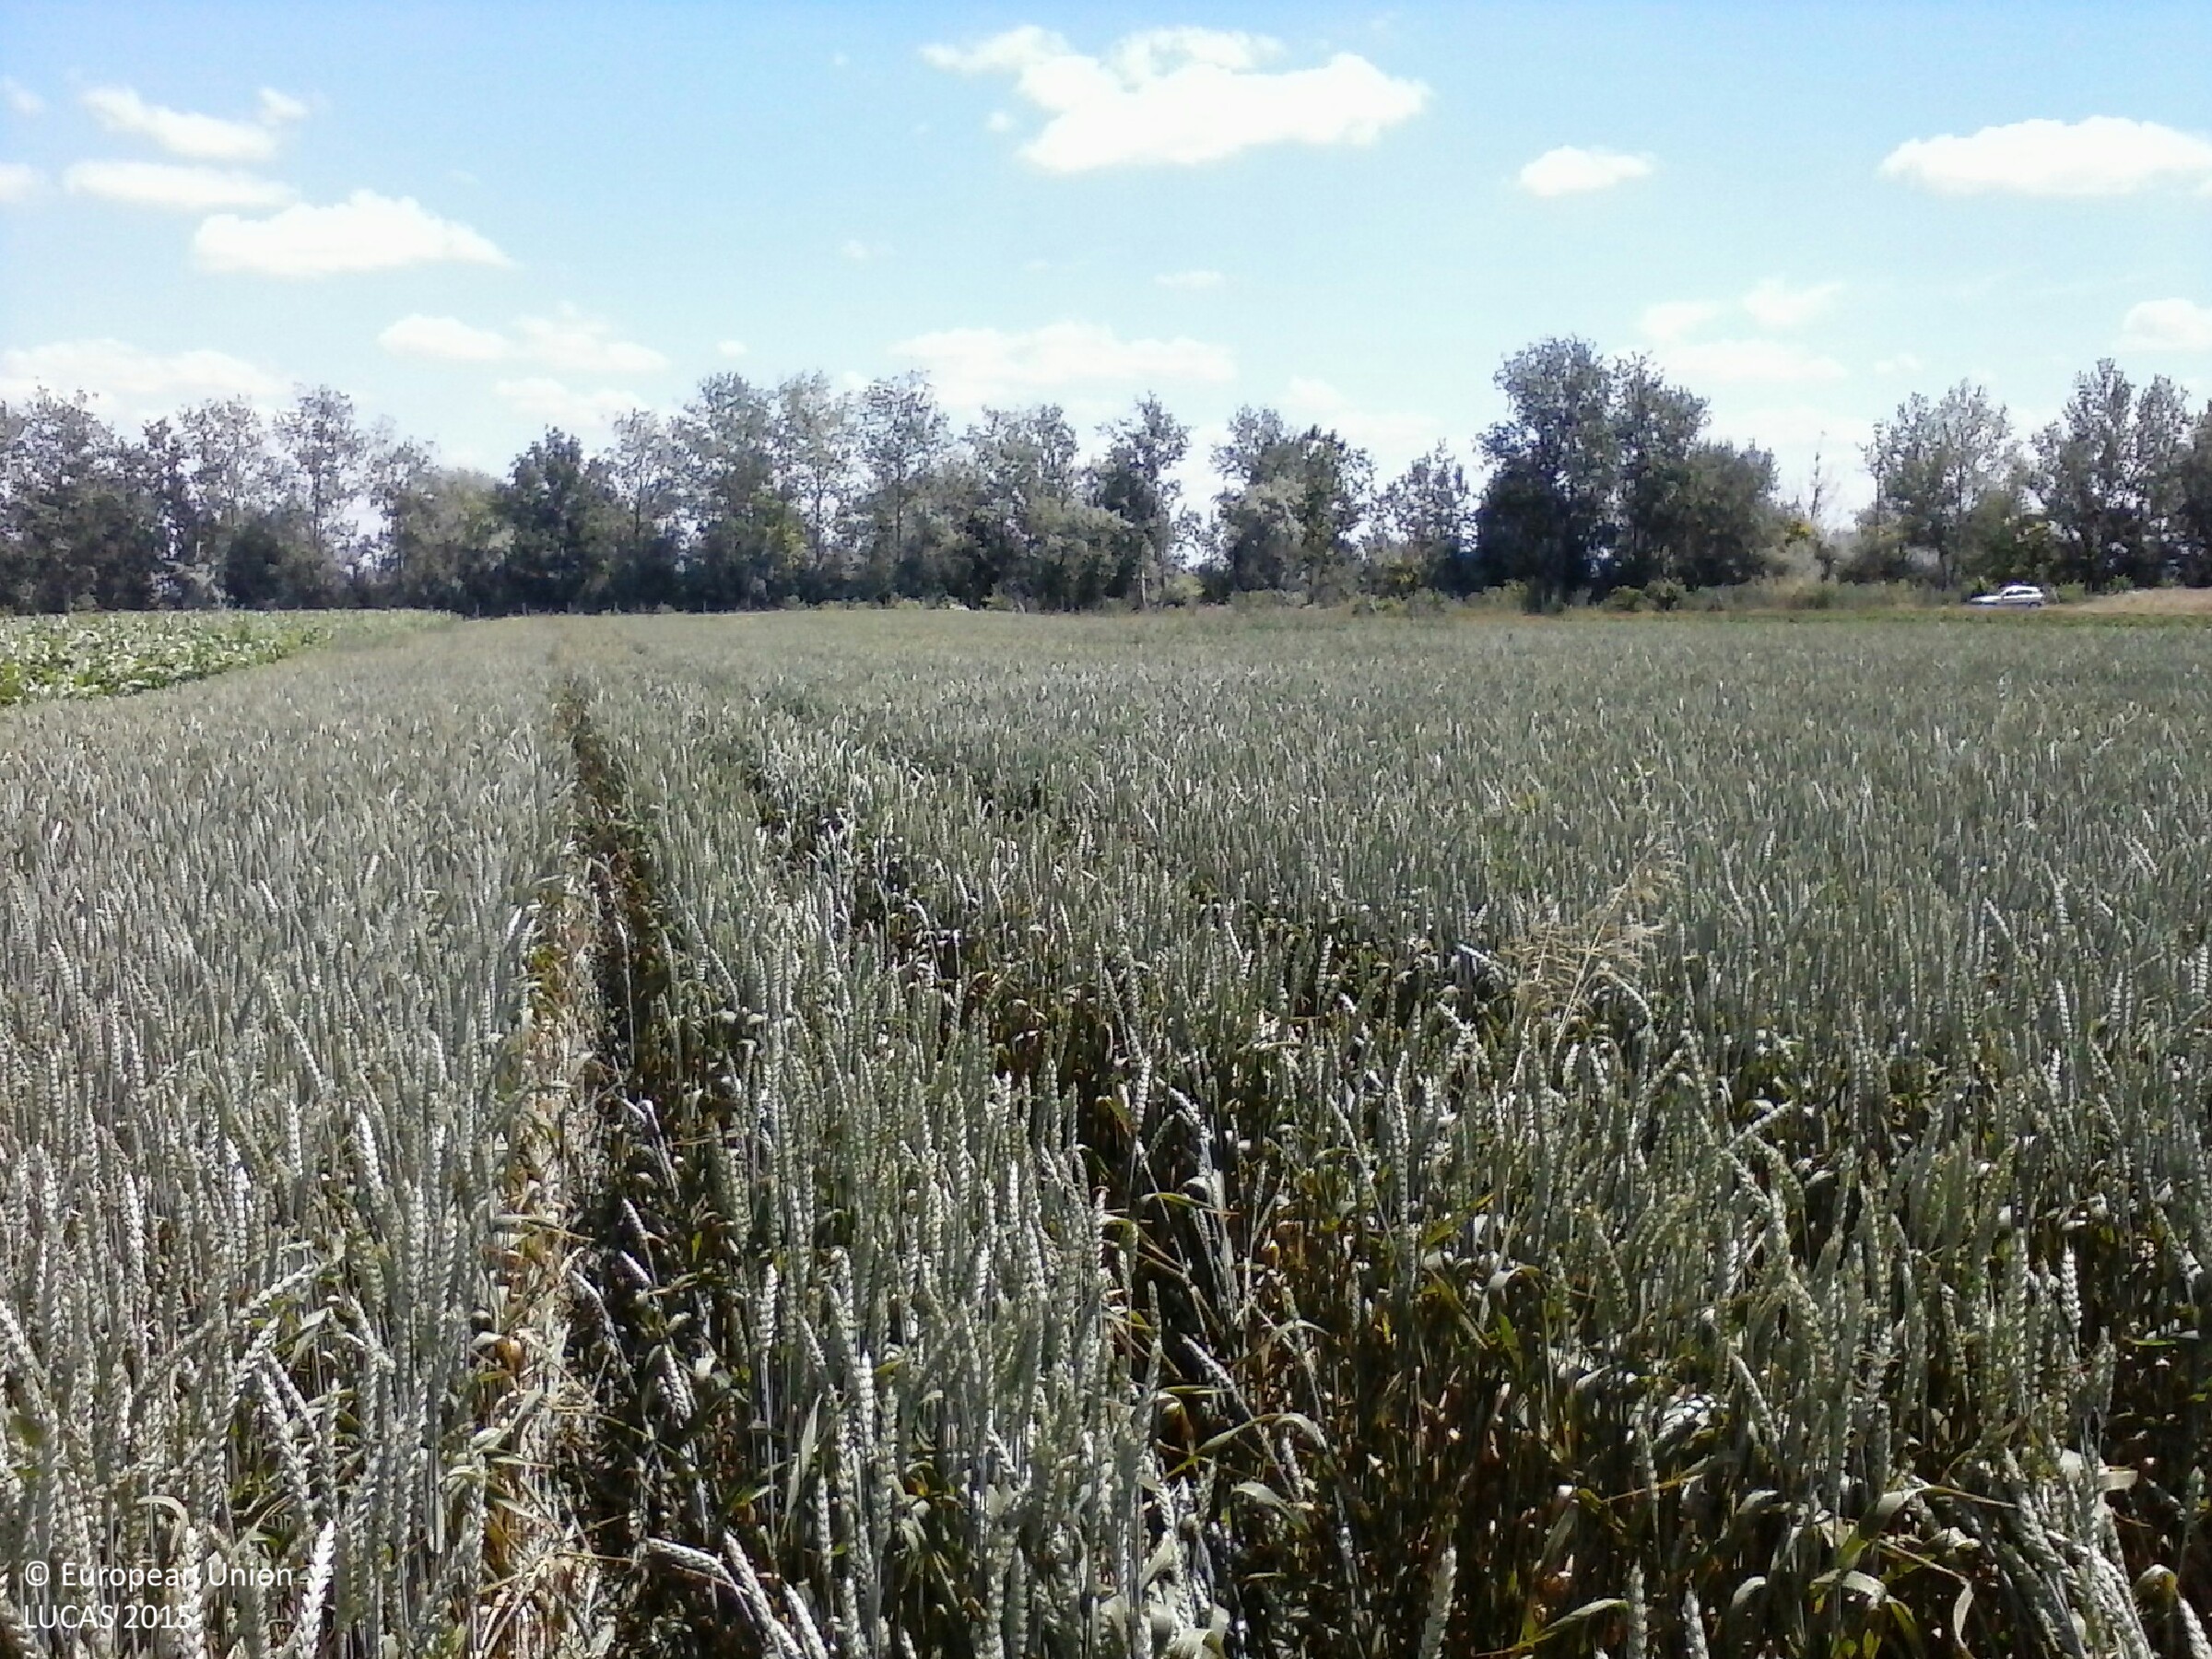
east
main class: Cropland
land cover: Common wheat
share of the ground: > 75 %
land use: Agriculture (excluding fallow land and kitchen gardens)
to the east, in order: Common wheat; Grass margins; Tracks; Grass margins; Fences; Grass margins; Ditches and canals; Lines of trees; Grassland with sparse tree/shrub cover; Lines of trees; Grassland without tree/shrub cover; Lines of trees; Grassland without tree/shrub cover; Paved roads, cycling and walking lanes; Grassland without tree/shrub cover; Inland fresh water bodies
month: June
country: HU
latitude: 46.2376
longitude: 20.0714
